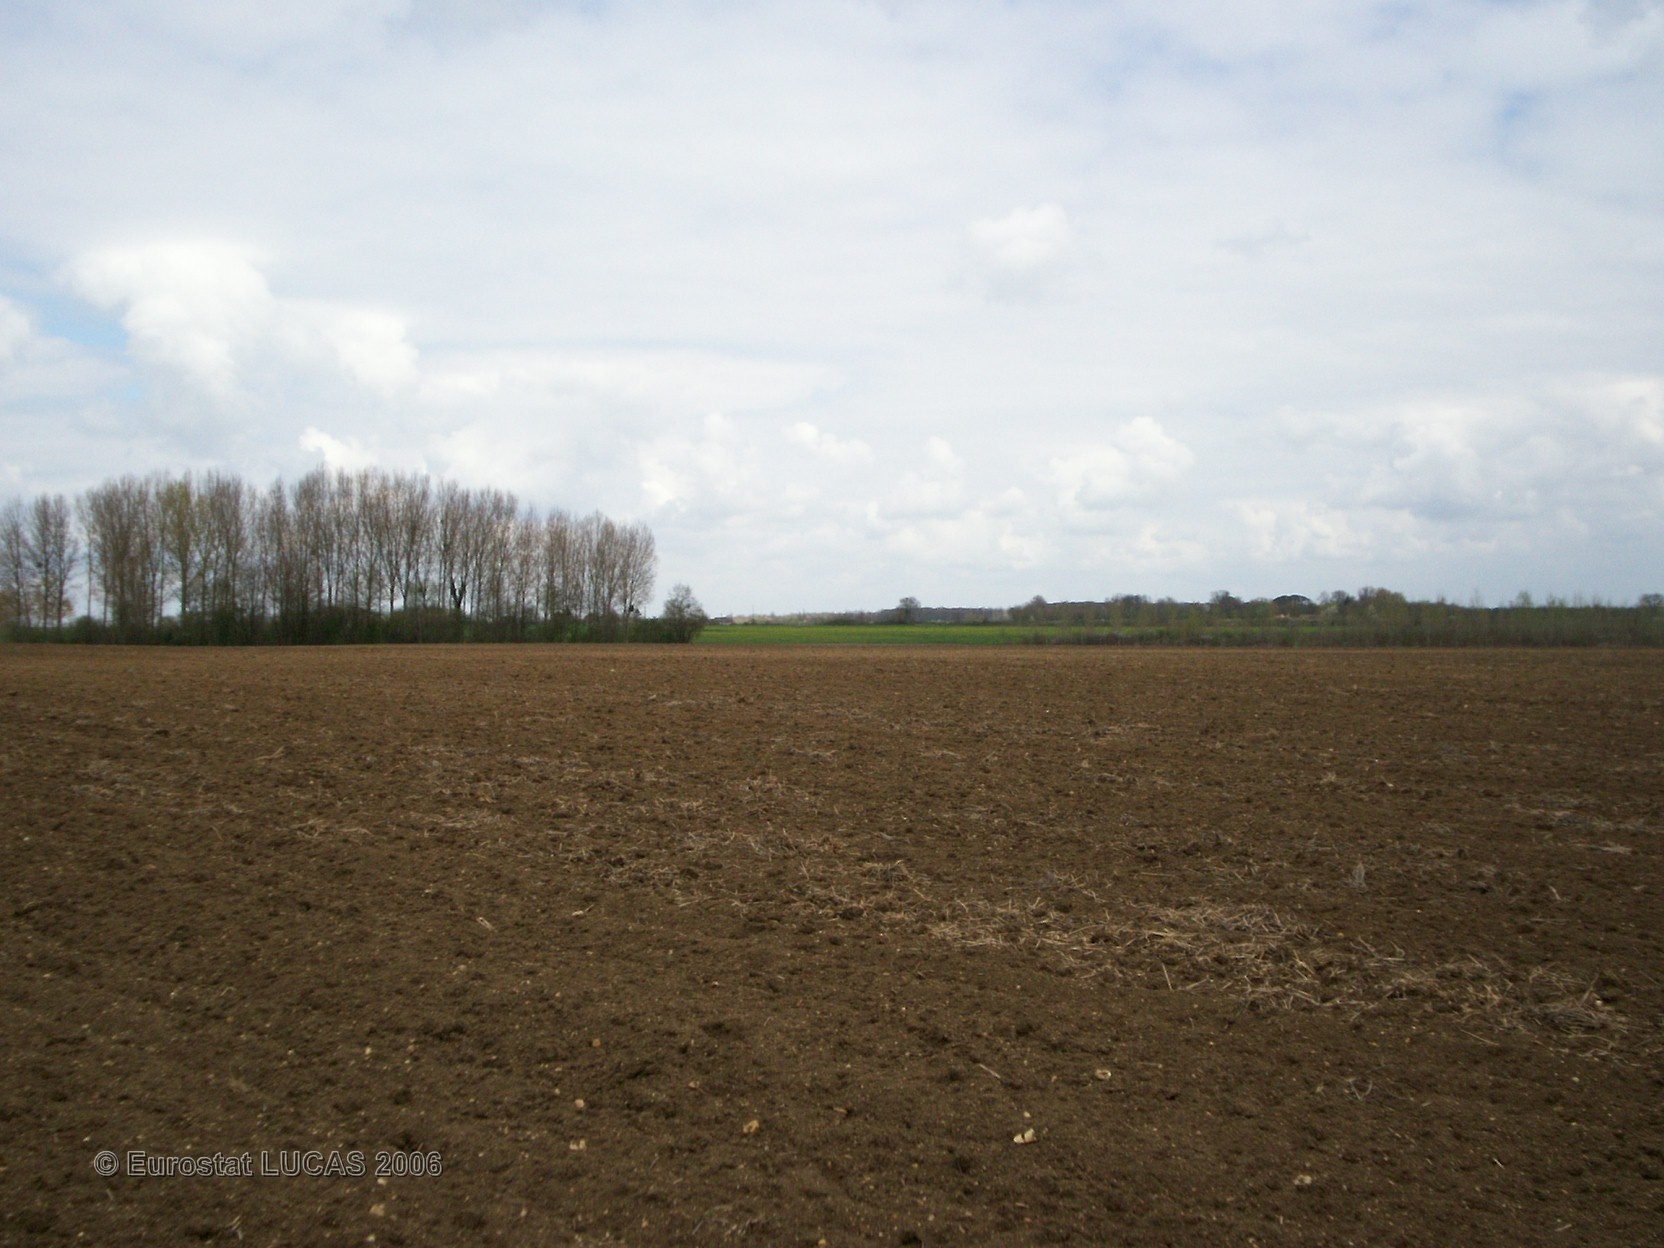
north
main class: Cropland
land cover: Sunflower
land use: Agriculture (excluding fallow land and kitchen gardens)
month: May
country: FR
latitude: 47.5154
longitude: 0.2158
